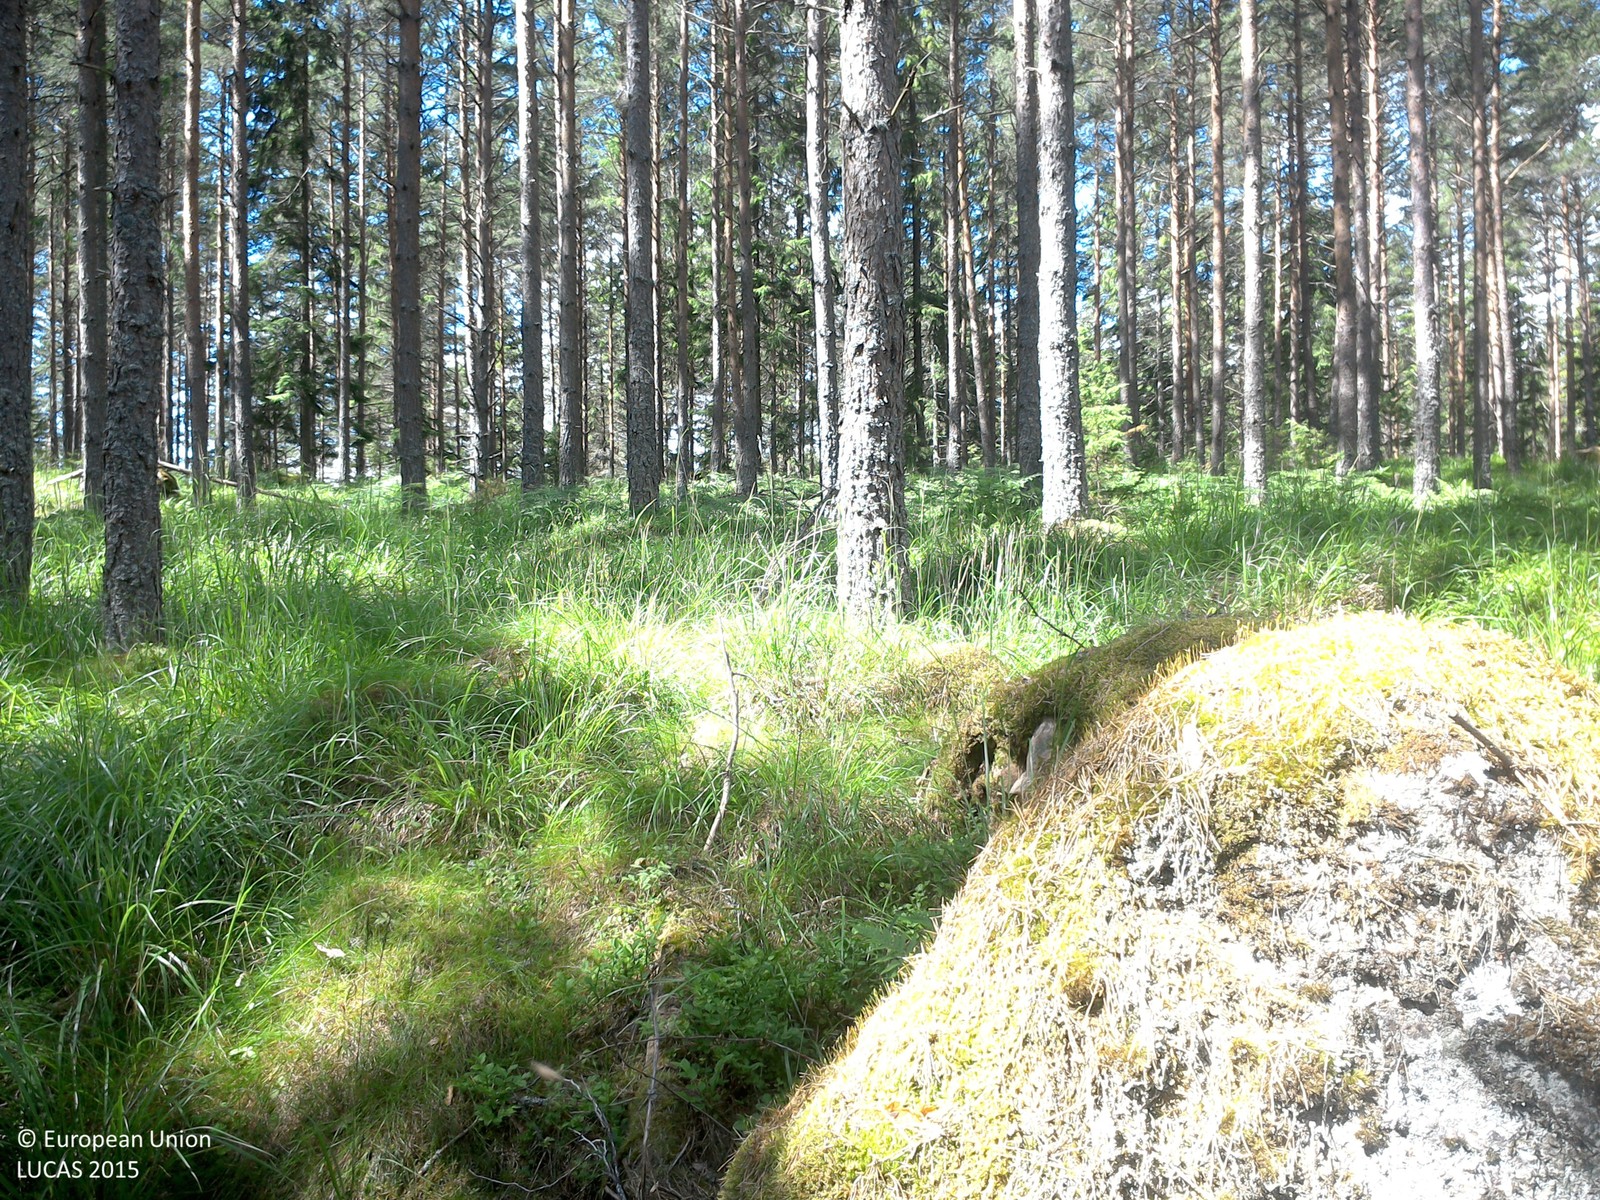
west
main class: Woodland
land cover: Pine dominated coniferous woodland
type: boreal forest
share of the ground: 50 - 75 %
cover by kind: coniferous forest trees 70 %, herbaceous plants 30 %
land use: Forestry
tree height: > 5 m
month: June
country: SE
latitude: 57.9804
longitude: 15.9318
